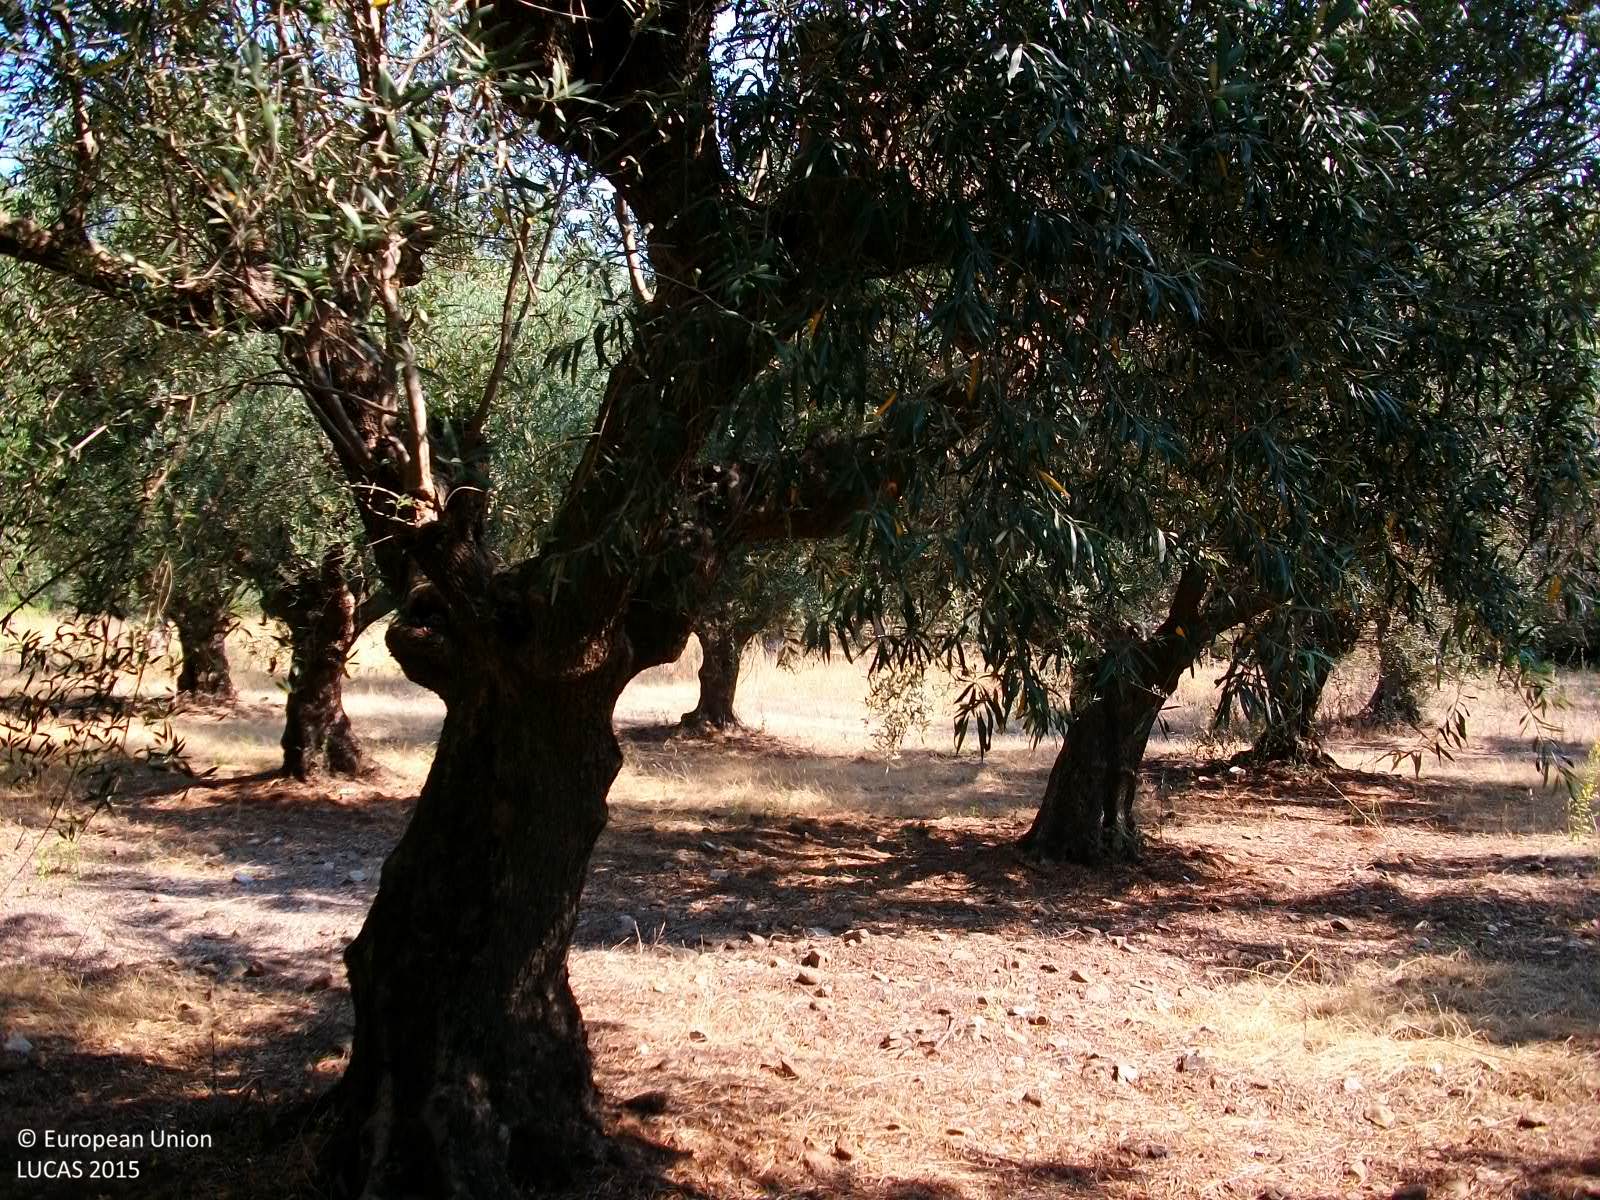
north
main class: Cropland
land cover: Olive groves
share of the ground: 50 - 75 %
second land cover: Spontaneously vegetated surfaces
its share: > 75 %
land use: Agriculture (excluding fallow land and kitchen gardens)
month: July
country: GR
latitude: 37.2969
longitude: 21.9934
